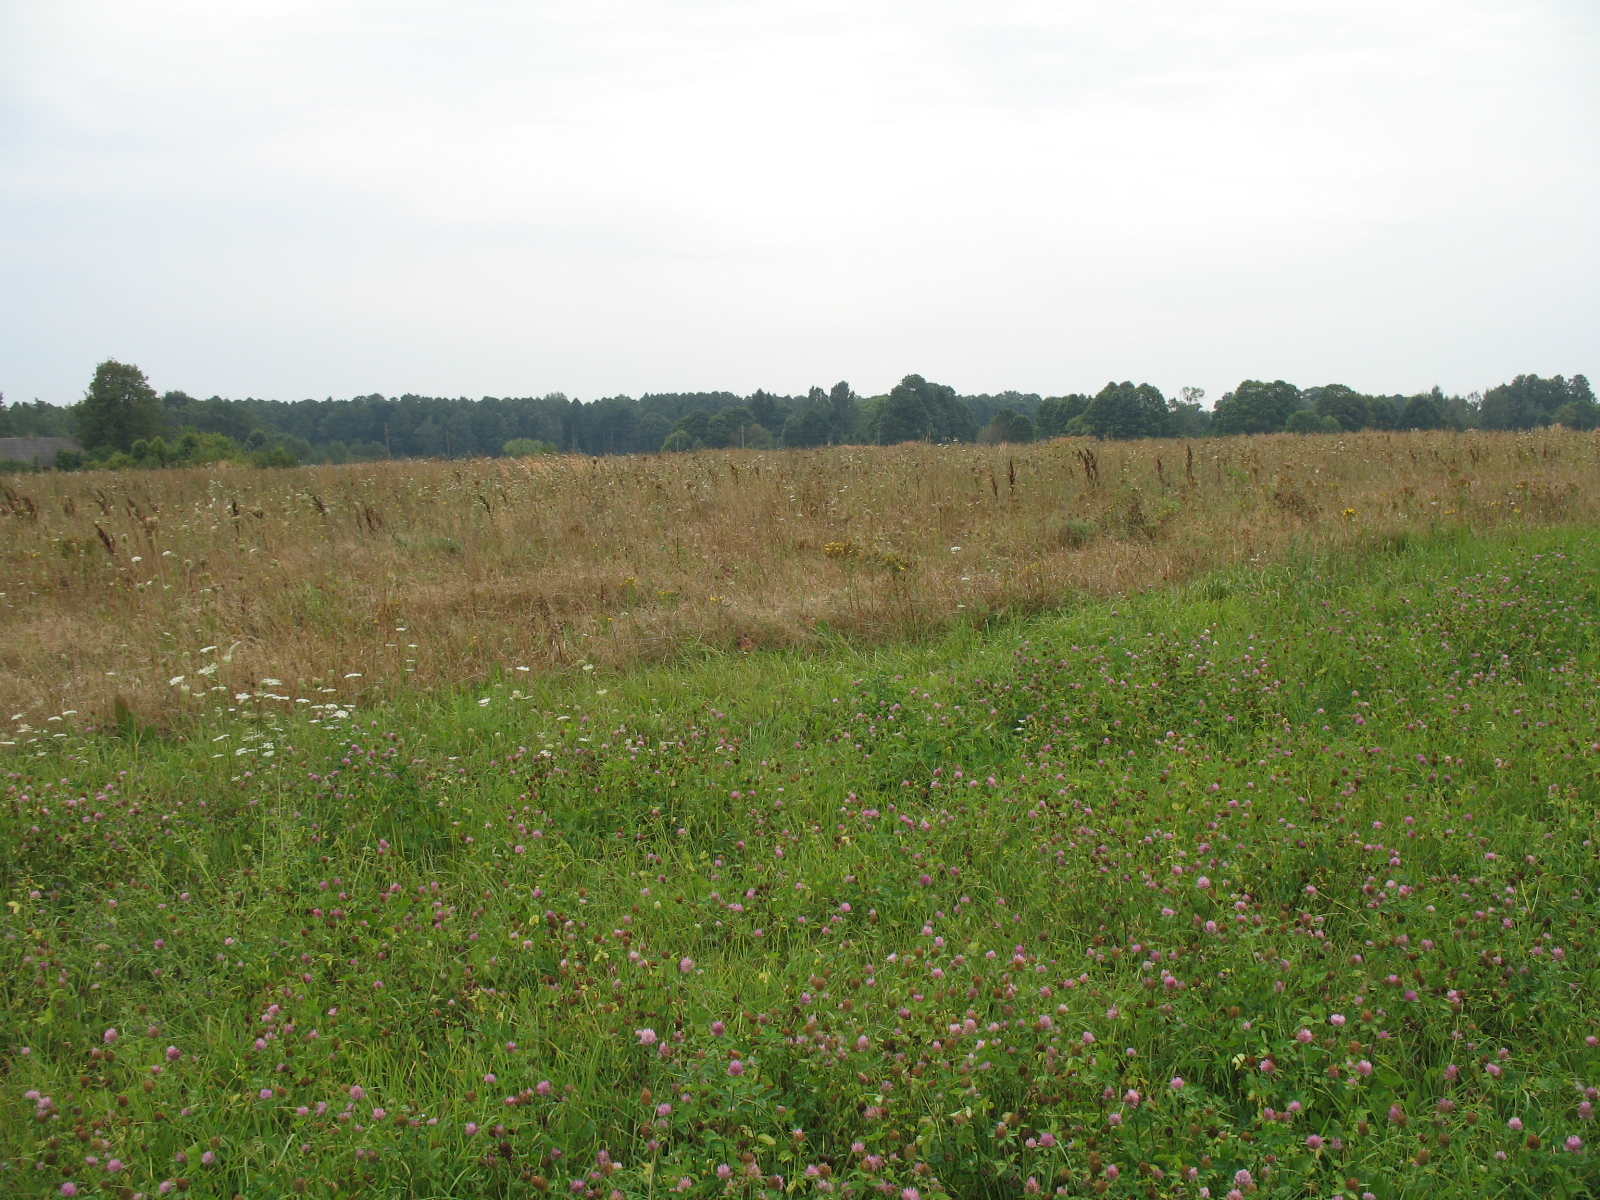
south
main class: Cropland
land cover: Clovers
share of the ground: > 75 %
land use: Agriculture (excluding fallow land and kitchen gardens)
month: August
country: LV
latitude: 56.3182
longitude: 25.9618
